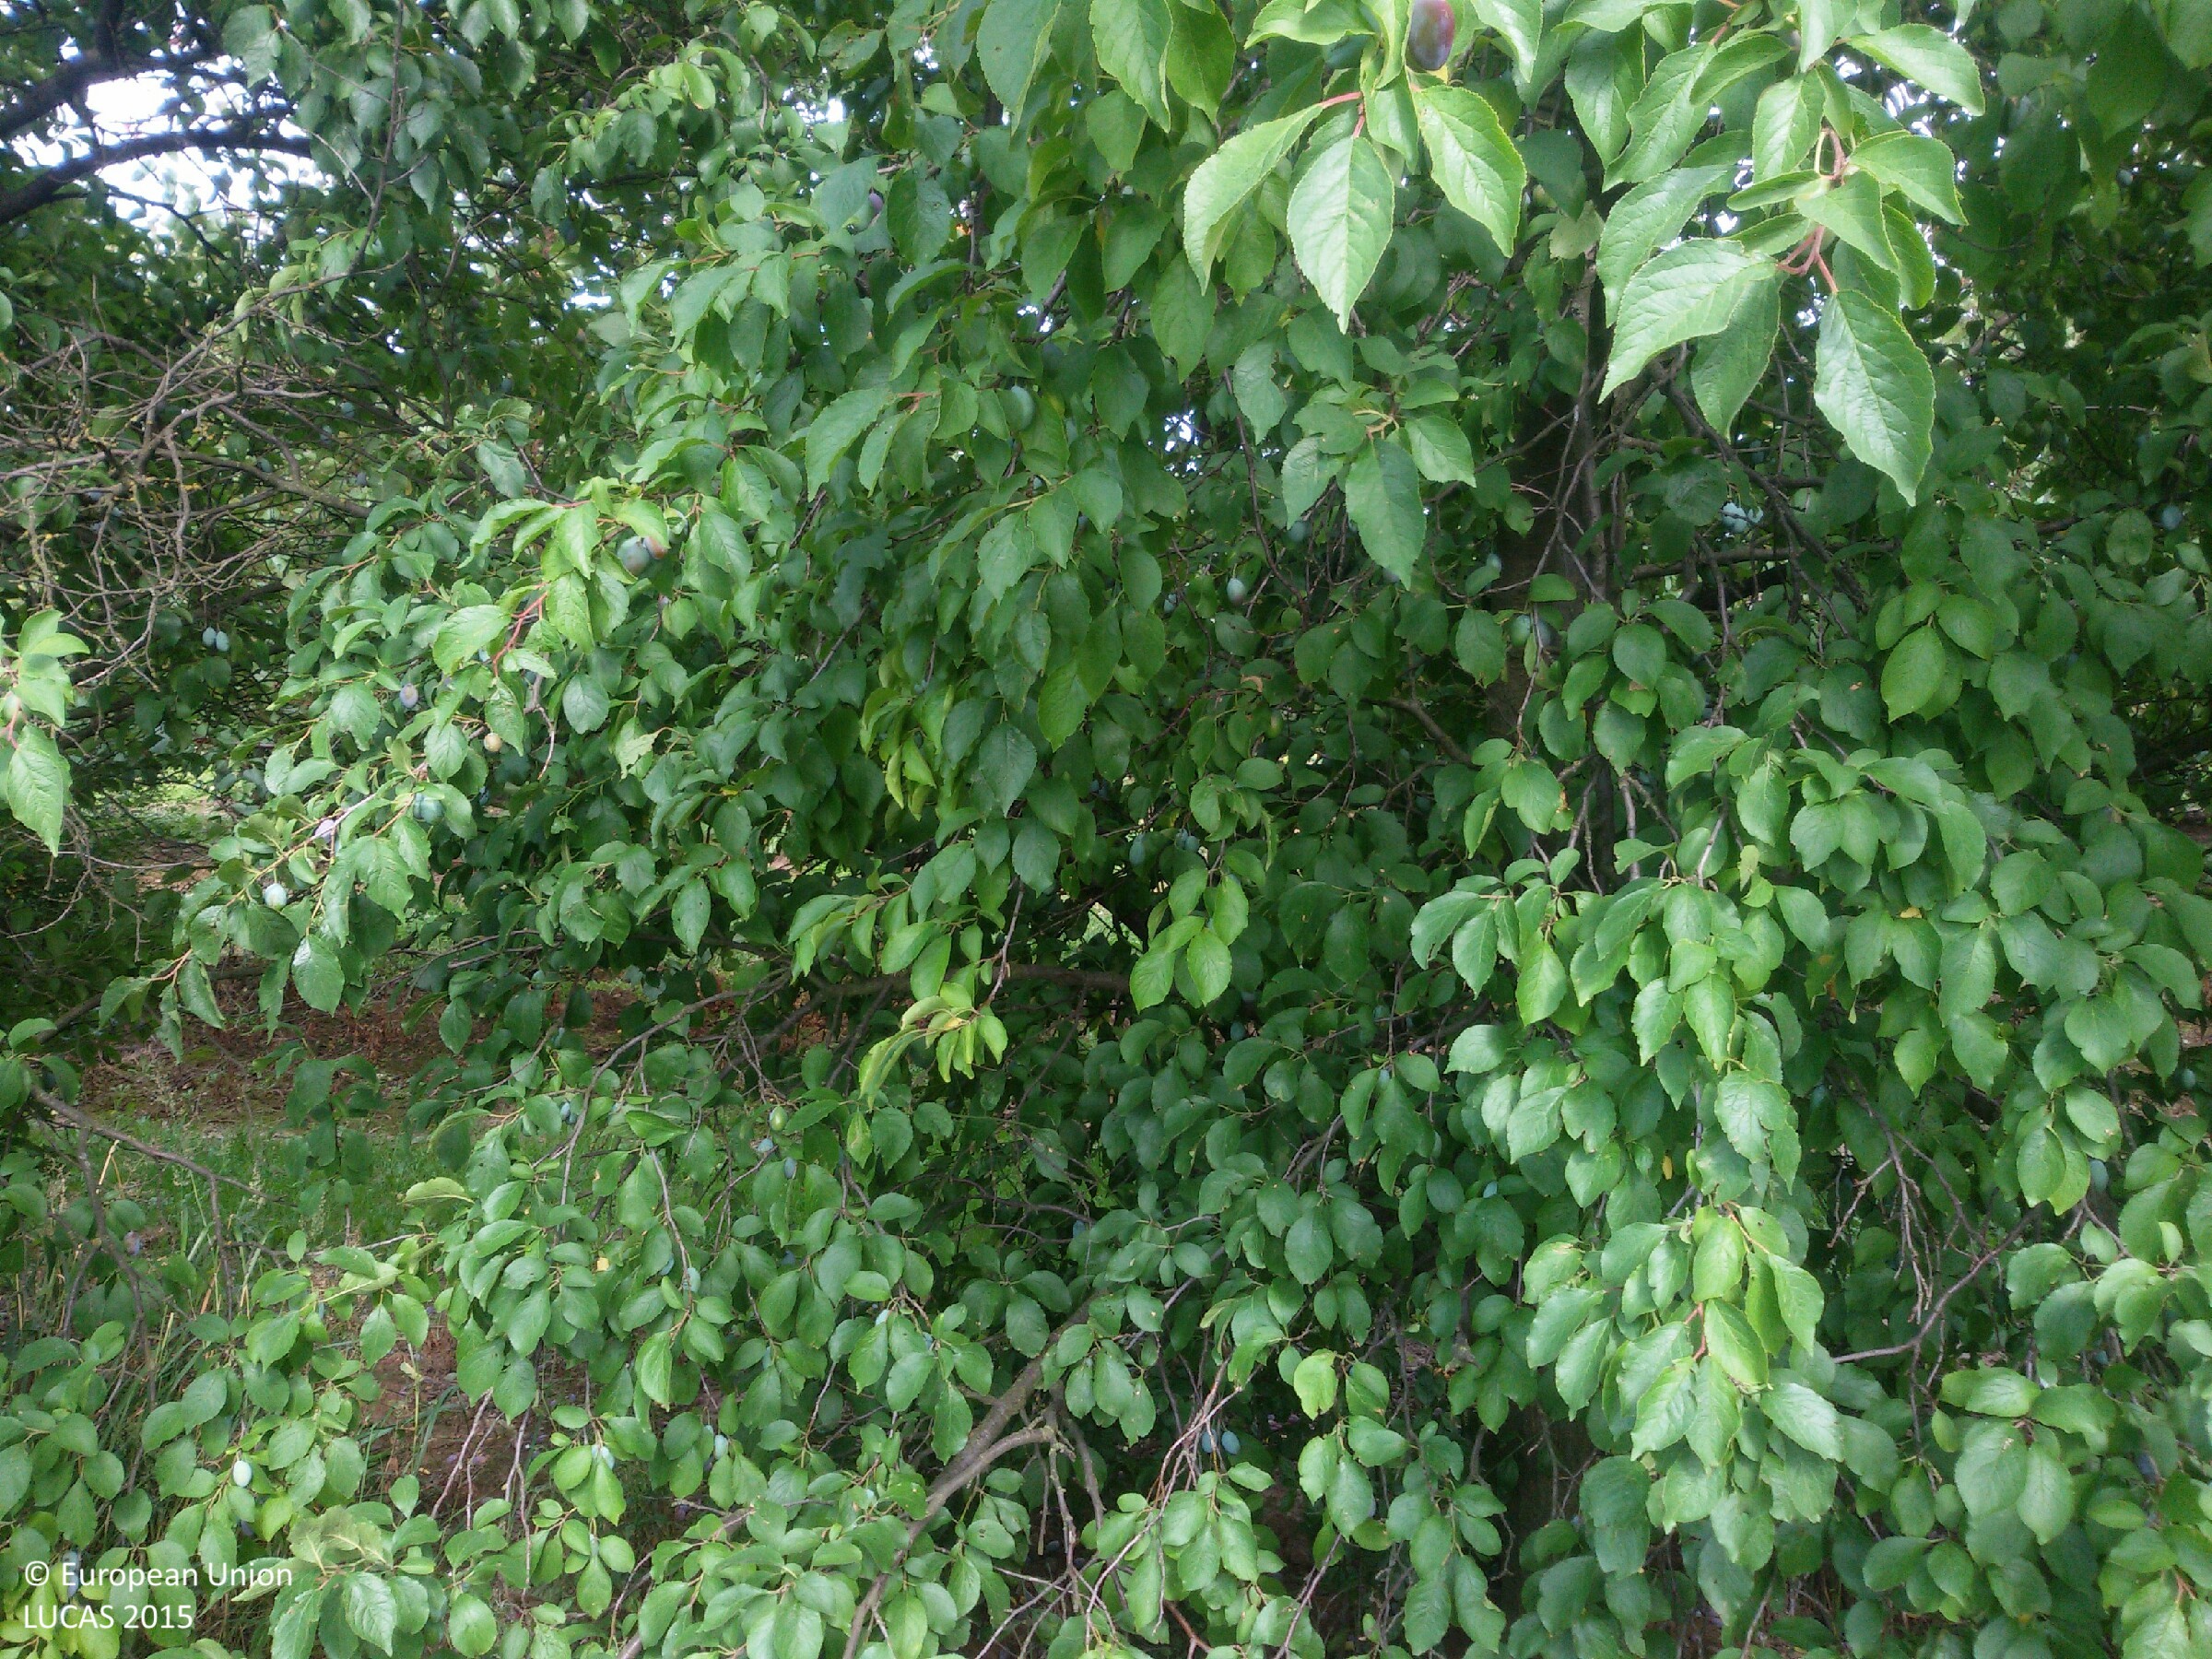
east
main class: Cropland
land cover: Other fruit trees and berries
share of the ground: > 75 %
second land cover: Grassland without tree/shrub cover
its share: > 75 %
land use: Agriculture (excluding fallow land and kitchen gardens)
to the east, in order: Other fruit trees and berries; Grassland without tree/shrub cover; Grass margins; Apple fruit; Tracks; Apple fruit; Grass margins; Pear fruit; Grass margins; Apple fruit; Paved roads, cycling and walking lanes; Cherry fruit; Apple fruit; Artificial constructions in urban areas
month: July
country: PL
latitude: 50.6877
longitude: 21.7030
